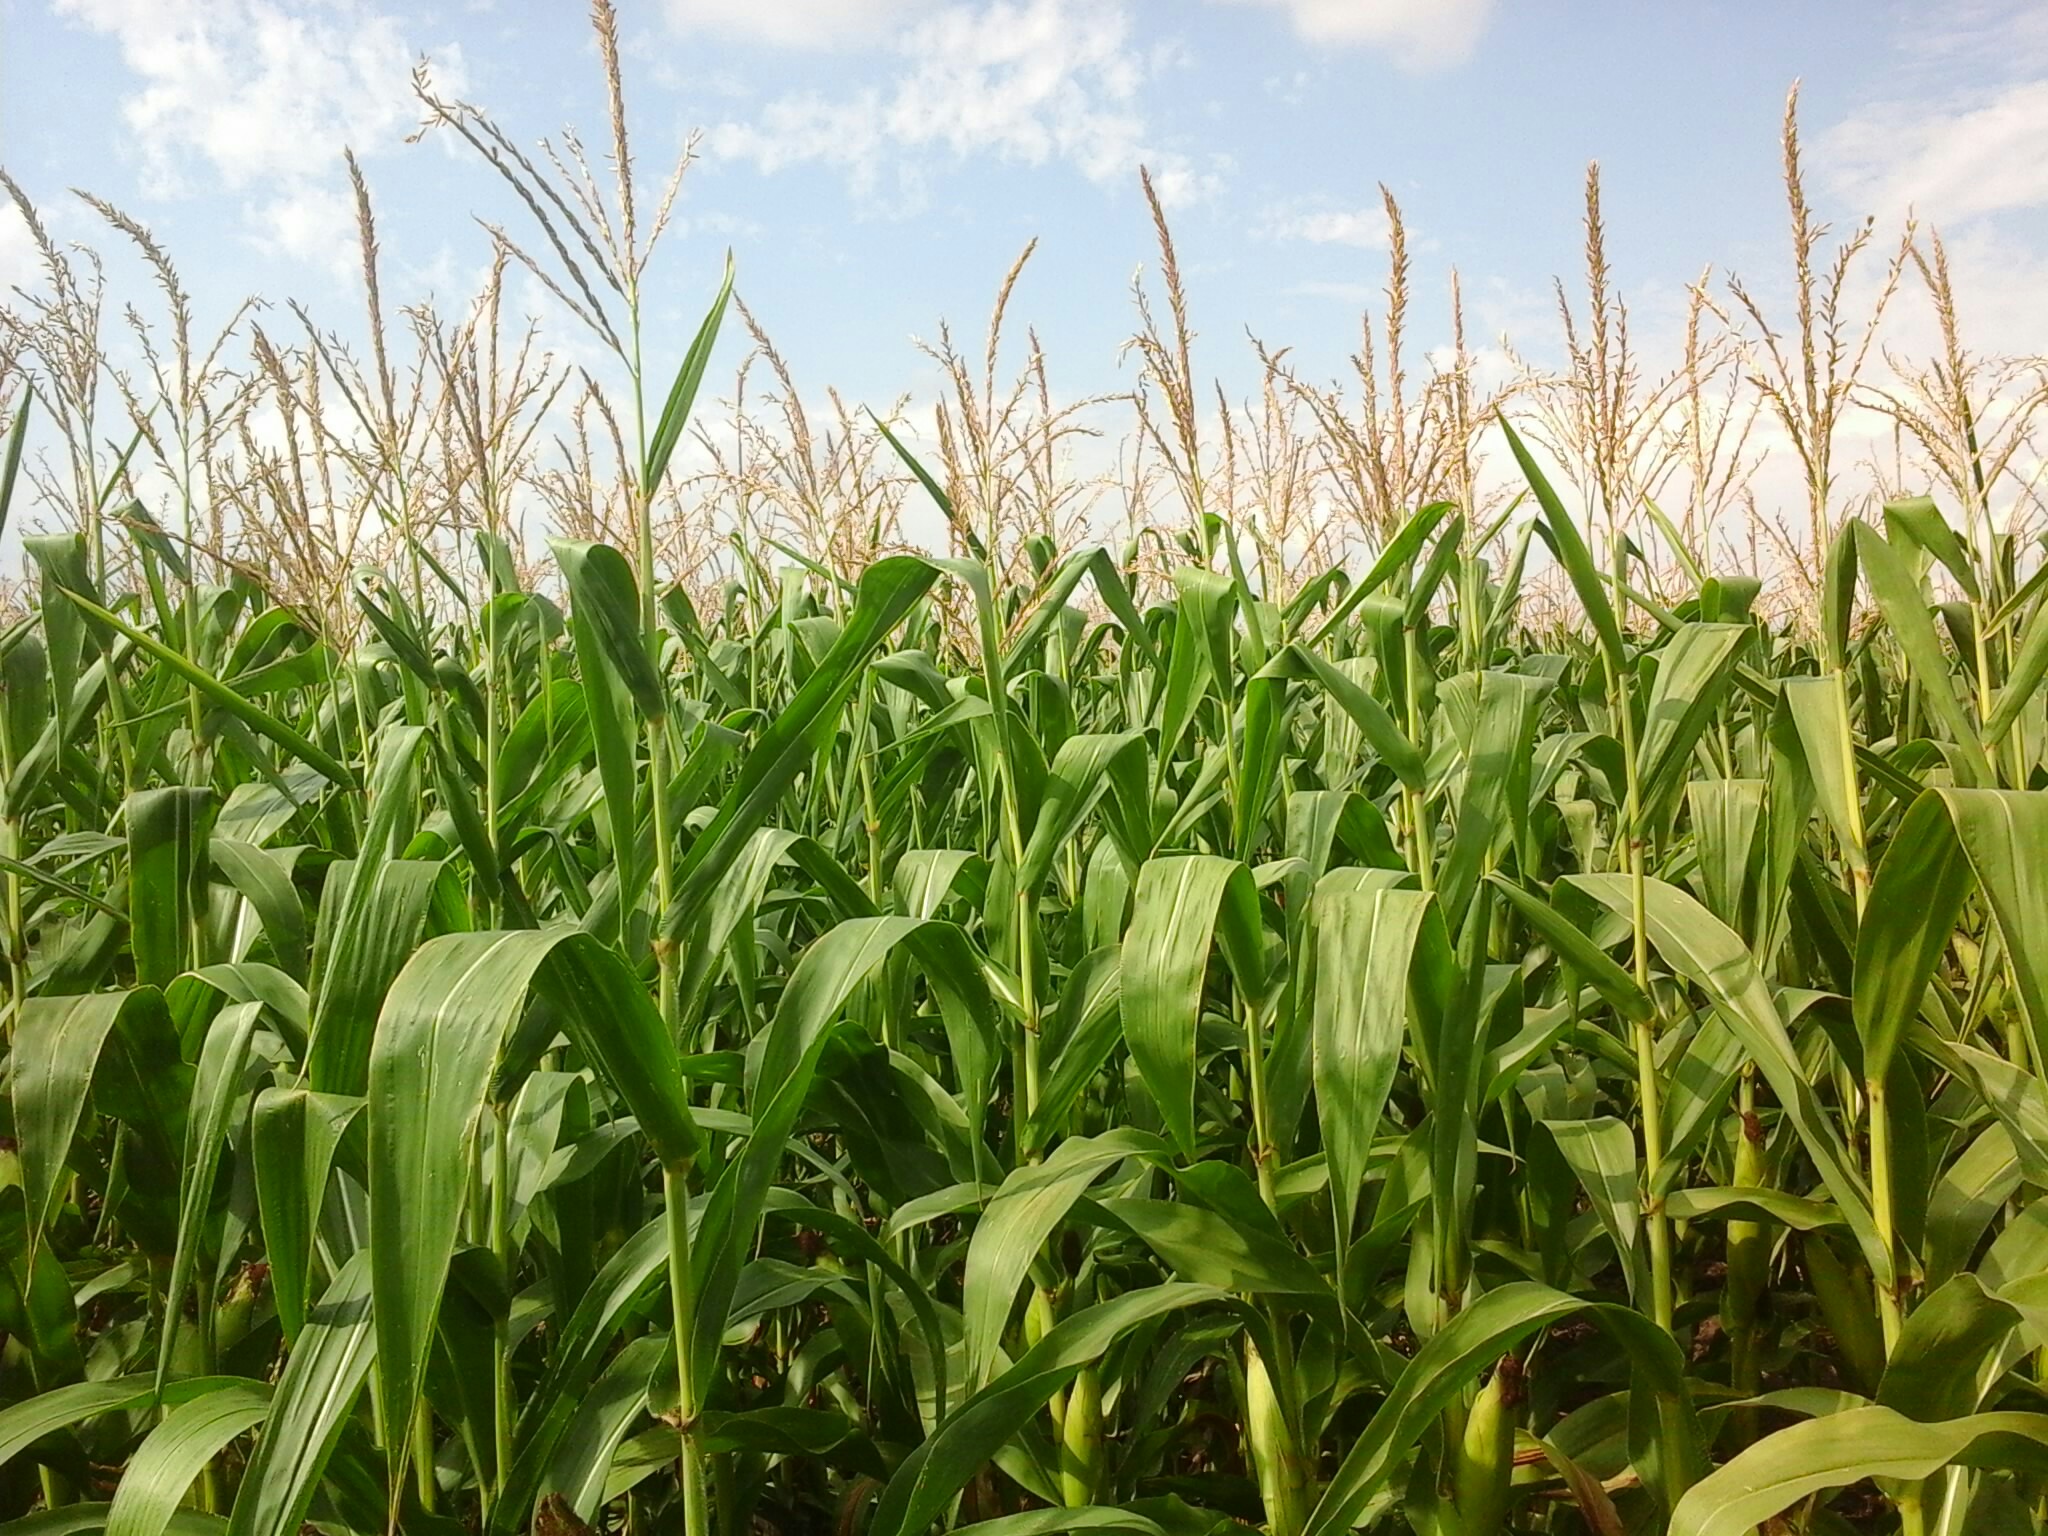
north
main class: Cropland
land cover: Maize
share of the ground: > 75 %
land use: Agriculture (excluding fallow land and kitchen gardens)
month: August
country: HU
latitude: 47.5372
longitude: 18.2087
